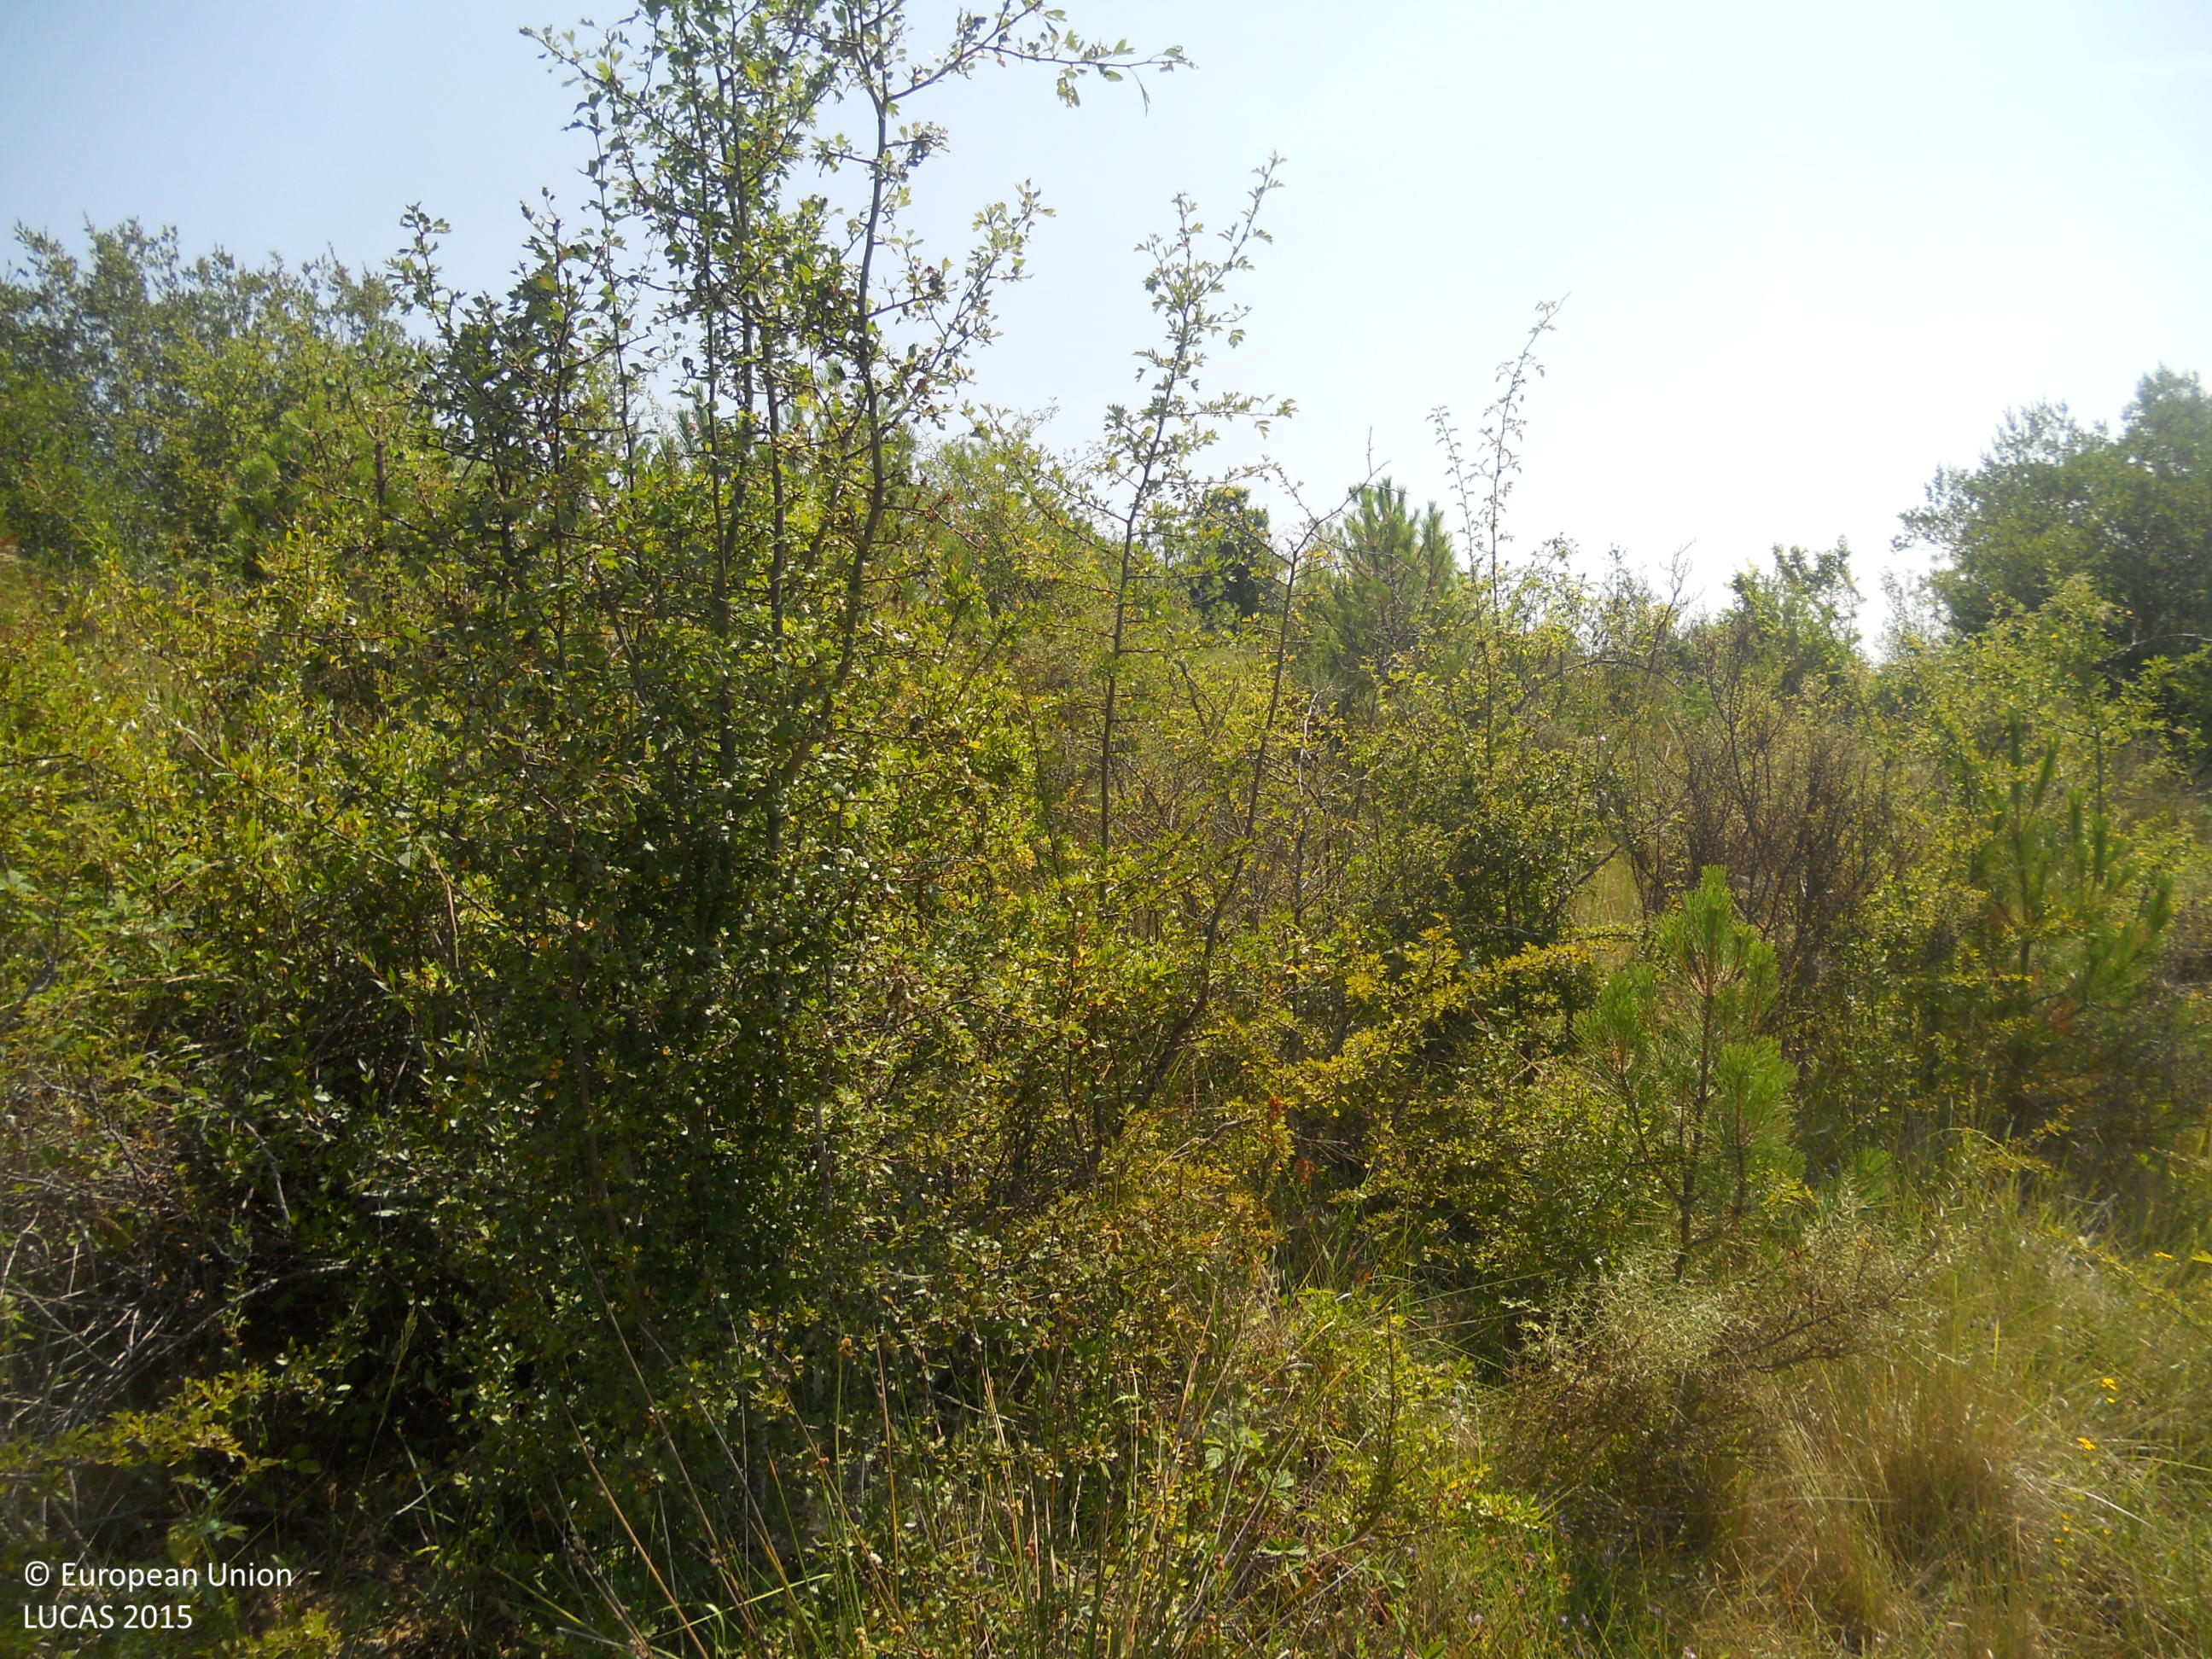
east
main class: Shrubland
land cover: Shrubland with sparse tree cover
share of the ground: > 75 %
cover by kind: shrubs 55 %, herbaceous plants 40 %, coniferous forest trees 5 %
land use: Semi-natural and natural areas not in use
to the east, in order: Shrubland with sparse tree cover; Pine dominated coniferous woodland; Grassland with sparse tree/shrub cover; Tracks; Grass margins; Common wheat; Grass margins; Tracks; Shrubland without tree cover; Other bare soil; Shruby margins; Rivers and streams; Broadleaved woodland; Shruby margins; Common wheat; Abandoned hedges; Grassland without tree/shrub cover; Tracks; Grass margins; Common wheat; Shrubland without tree cover; Common wheat
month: July
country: ES
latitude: 42.5932
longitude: -5.3627
